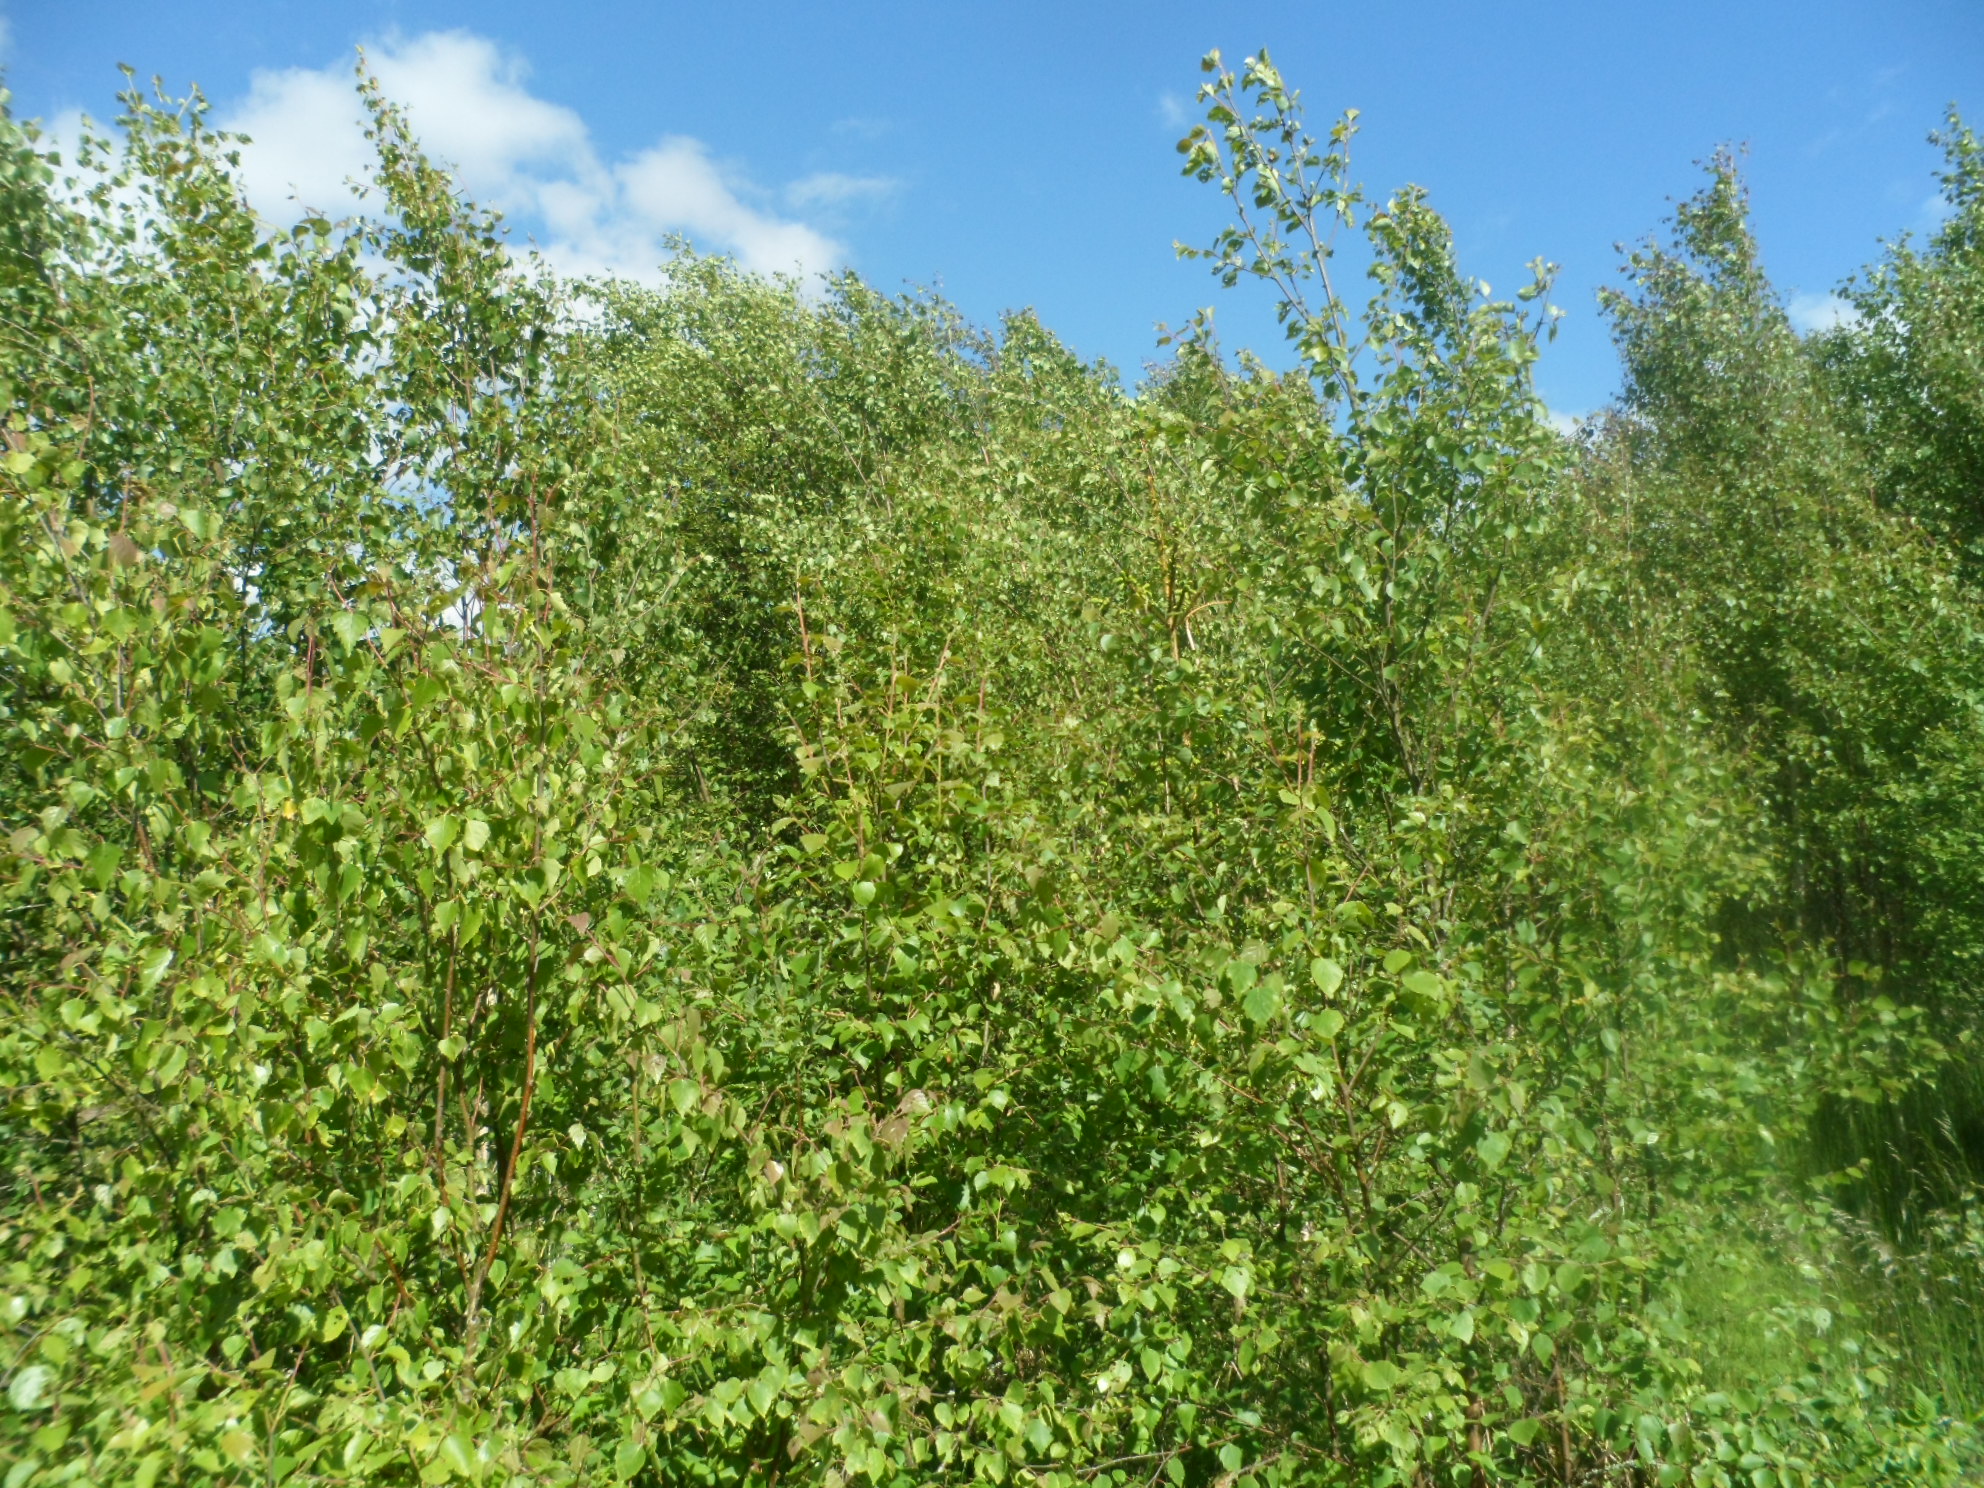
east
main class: Woodland
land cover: Broadleaved woodland
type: hemiboreal forest and nemoral coniferous forest and mixed broadleaved-coniferous forest
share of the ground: 50 - 75 %
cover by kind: broadleaved forest trees 65 %, herbaceous plants 20 %, coniferous forest trees 5 %, shrubs 5 %, lichens and mosses 5 %
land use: Forestry
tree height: < 5 m
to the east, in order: Broadleaved woodland; Tracks; Broadleaved woodland; Ditches and canals; Broadleaved woodland; Tracks; Spruce dominated coniferous woodland; Dry stone walls; Spruce dominated coniferous woodland
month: June
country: SE
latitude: 56.9836
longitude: 14.1926
